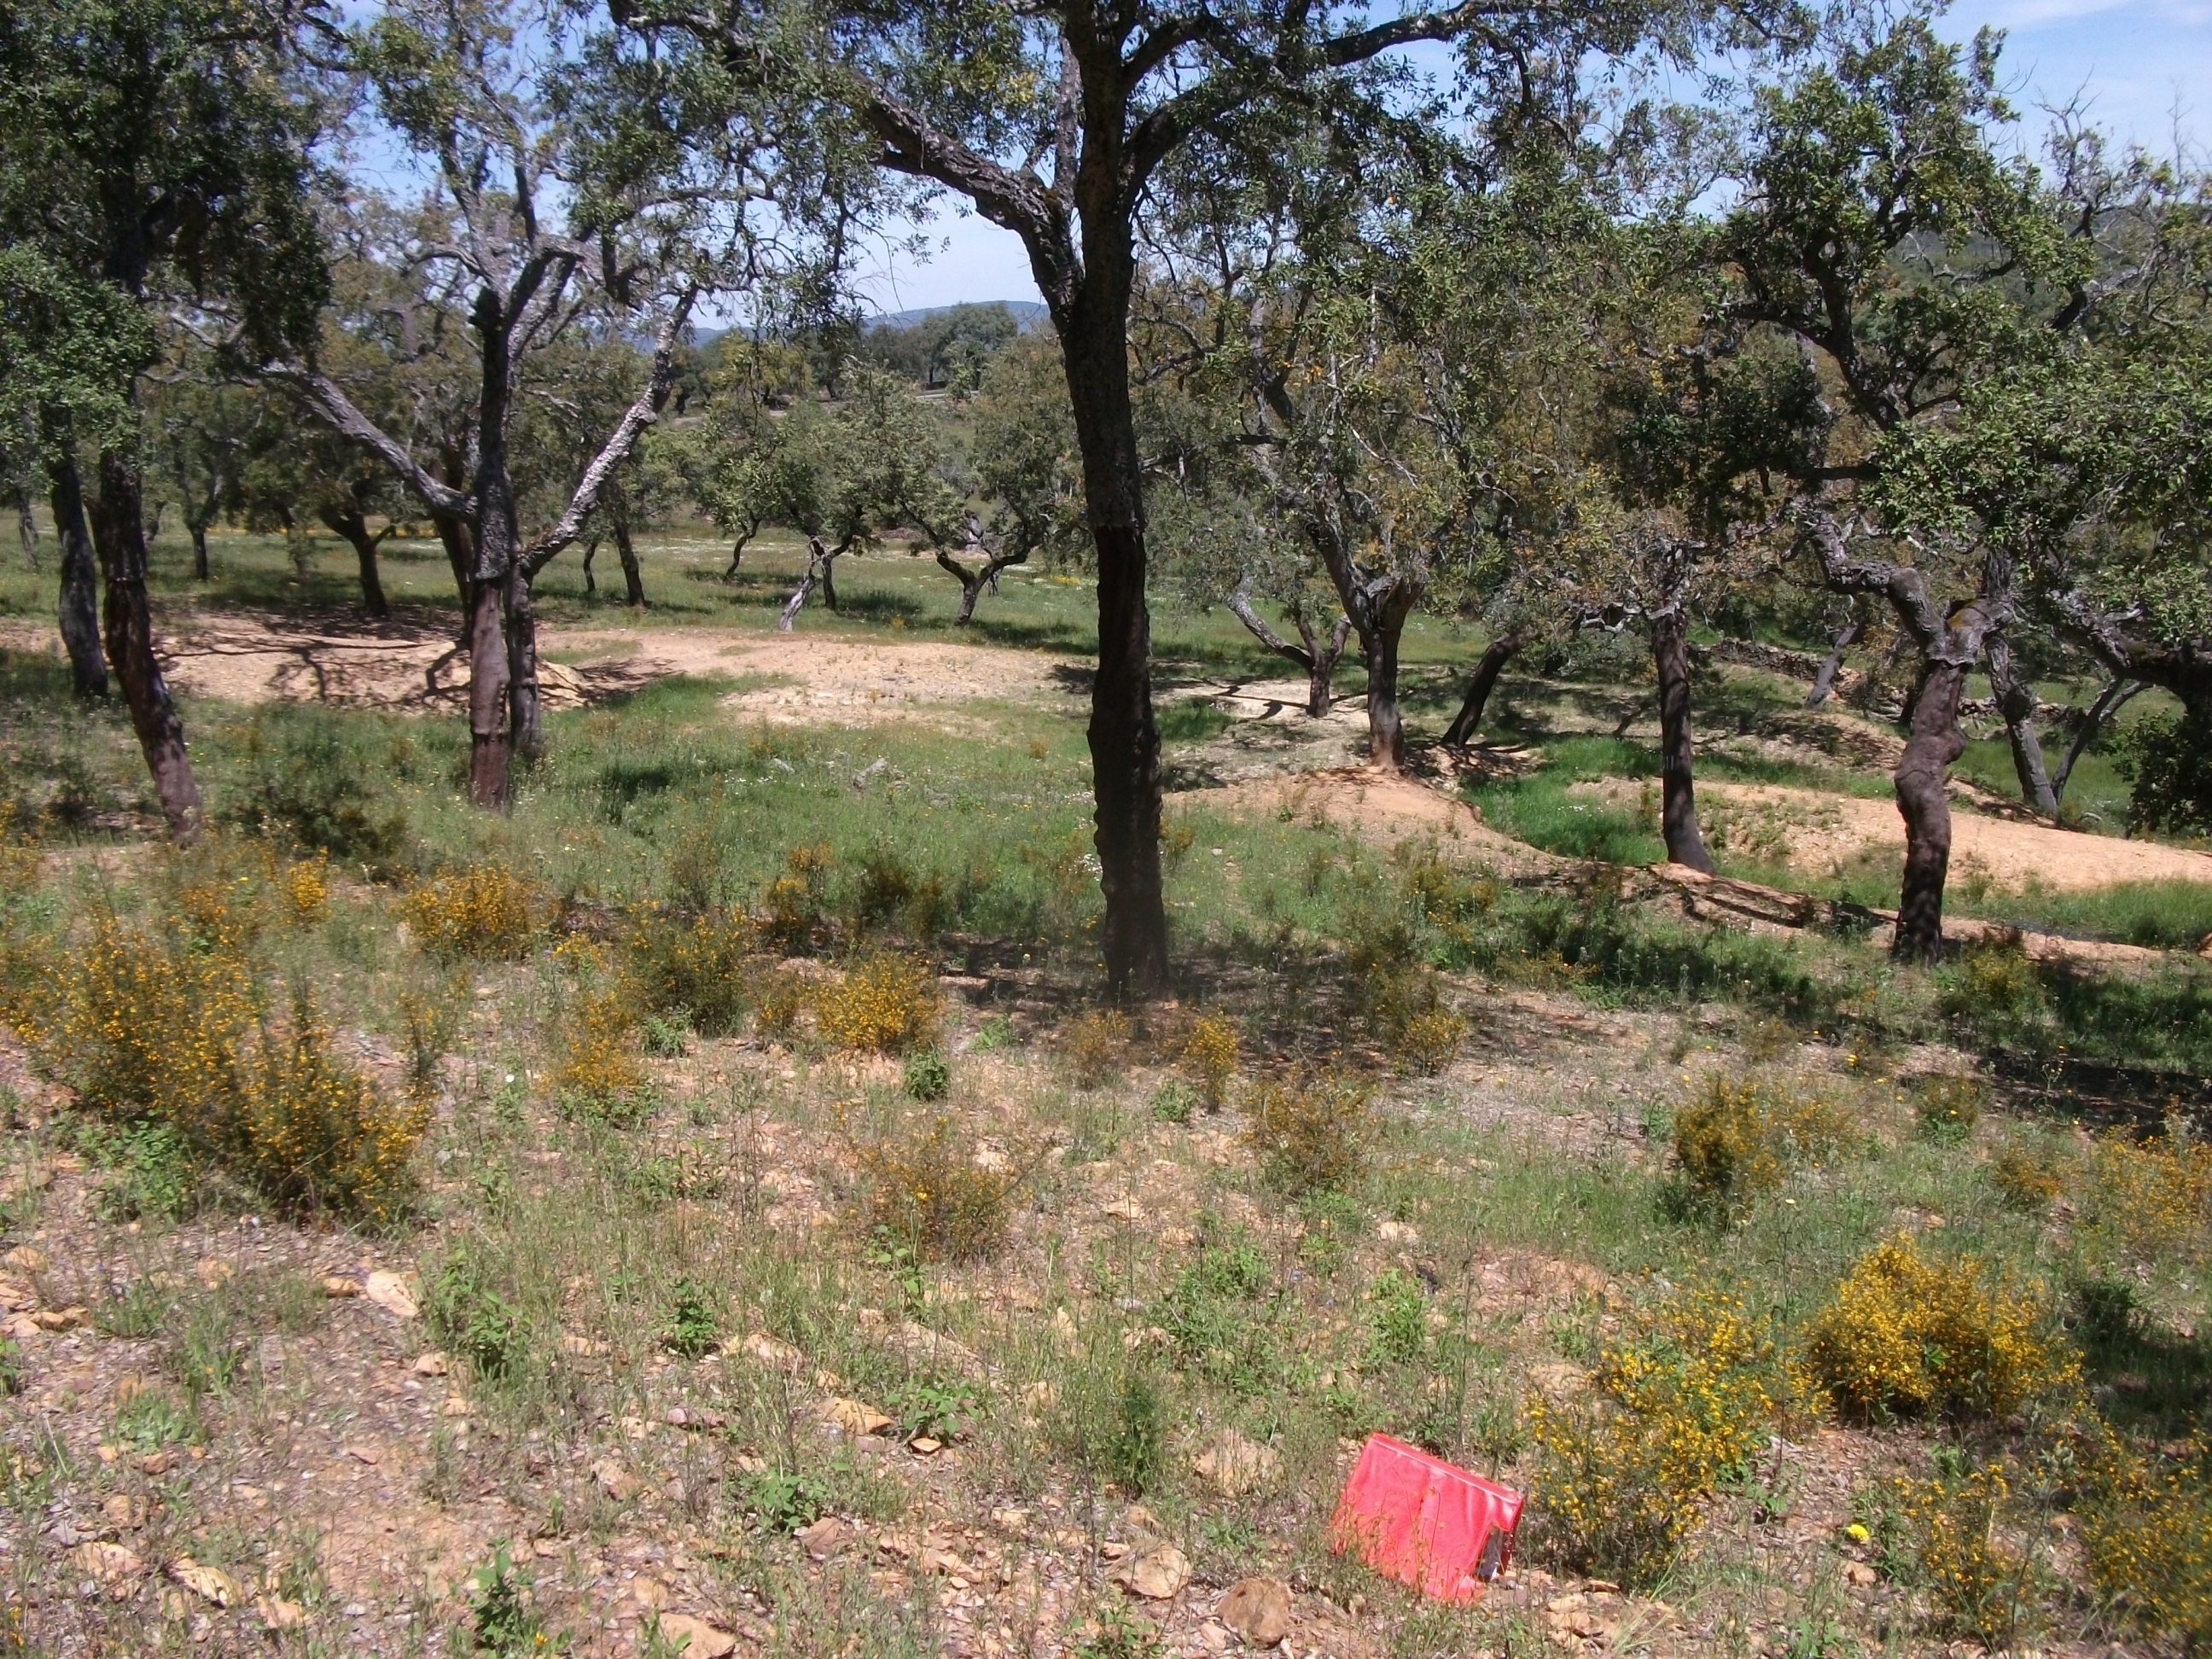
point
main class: Woodland
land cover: Broadleaved woodland
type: broadleaved evergreen forest
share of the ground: 50 - 75 %
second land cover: Spontaneously vegetated surfaces
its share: 10 - 25 %
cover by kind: broadleaved forest trees 70 %, herbaceous plants 20 %, shrubs 10 %
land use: Forestry
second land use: Agriculture (excluding fallow land and kitchen gardens)
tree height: > 5 m
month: April
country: ES
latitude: 37.7617
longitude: -6.5569
